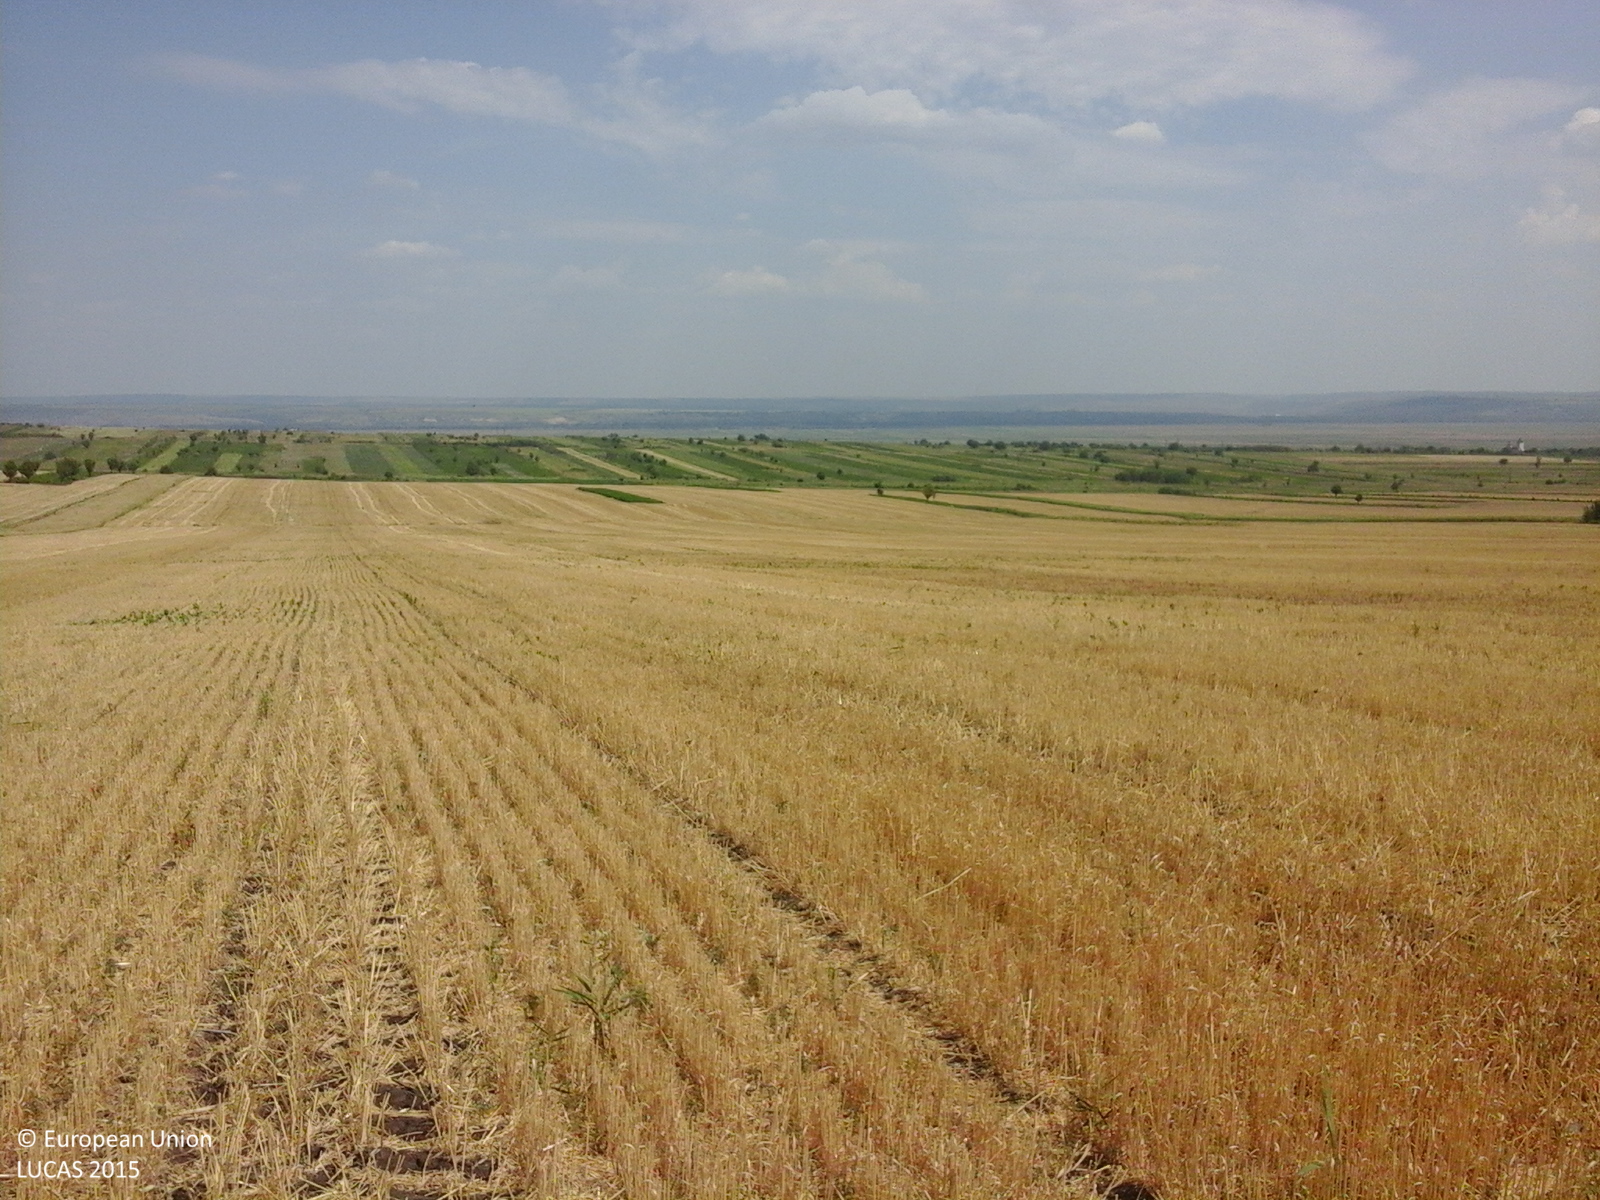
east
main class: Cropland
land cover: Common wheat
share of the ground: > 75 %
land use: Agriculture (excluding fallow land and kitchen gardens)
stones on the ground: < 10 %
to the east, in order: Common wheat
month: July
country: RO
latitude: 46.6270
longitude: 28.1428
